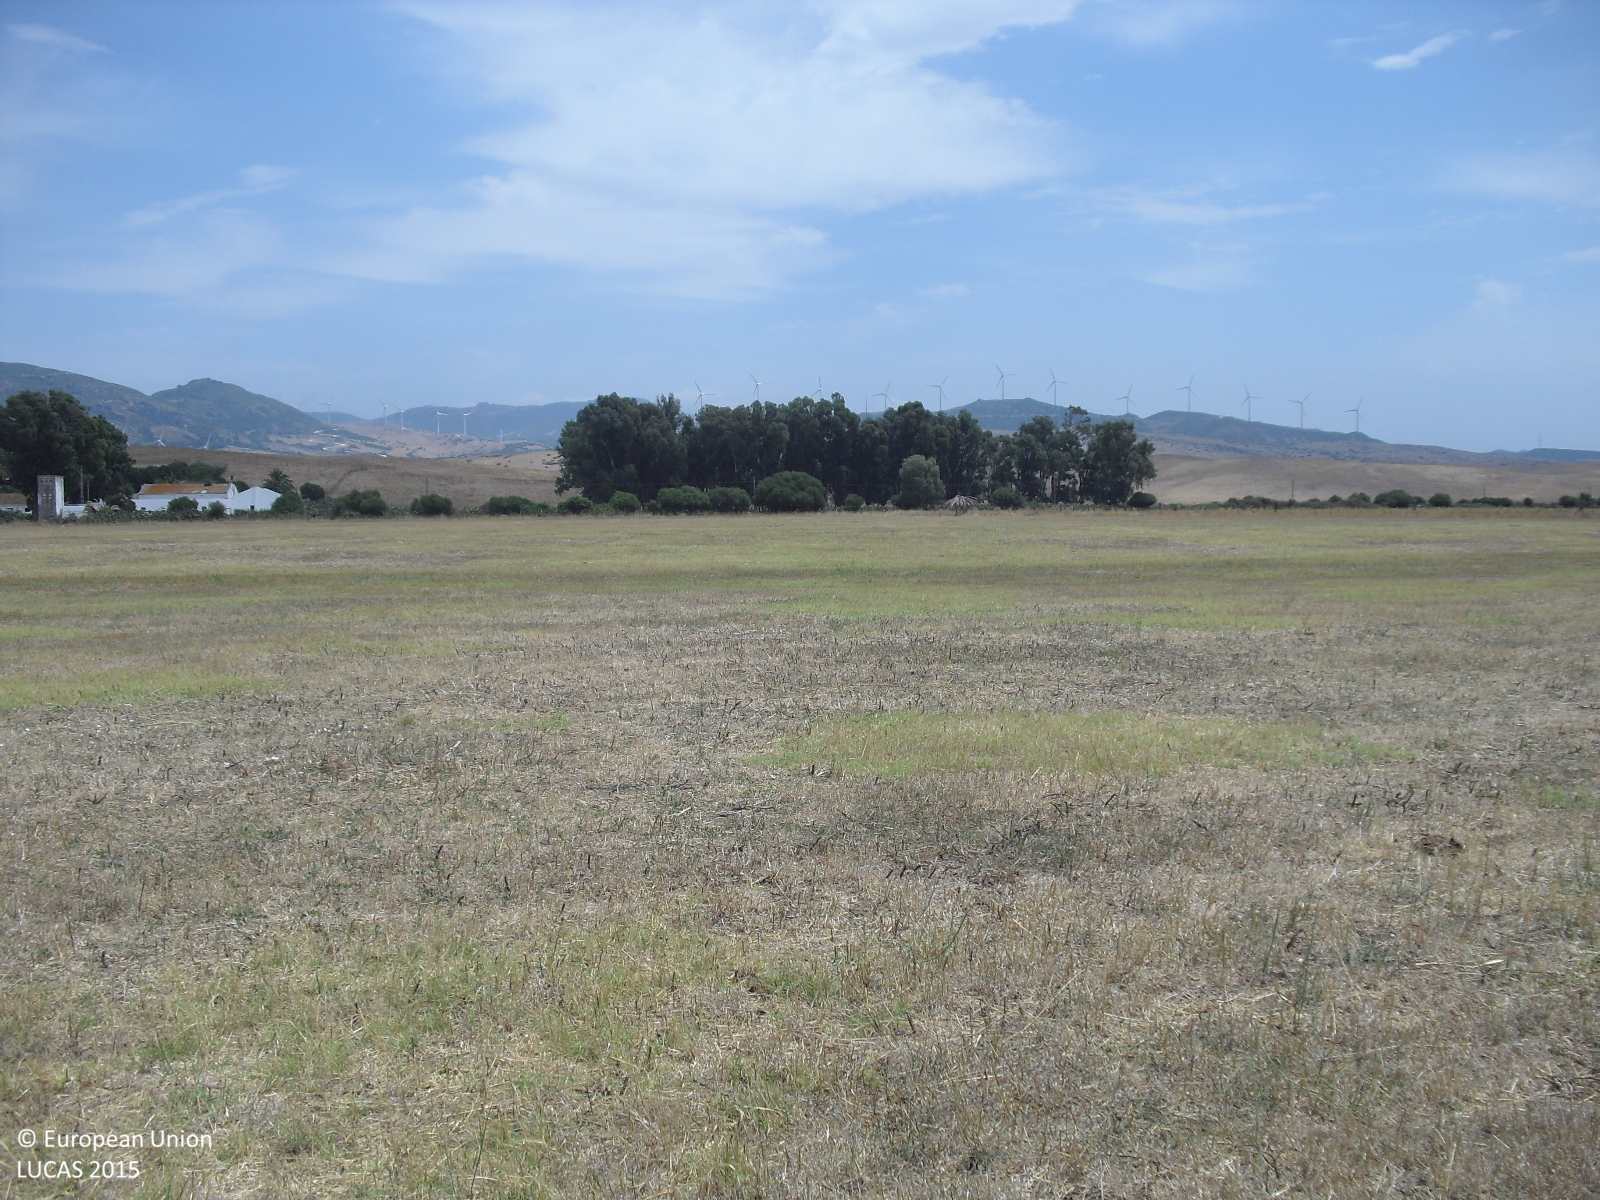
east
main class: Grassland
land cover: Spontaneously vegetated surfaces
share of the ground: 25 - 50 %
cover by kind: unconsolidated bare surface 65 %, herbaceous plants 35 %
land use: Agriculture (excluding fallow land and kitchen gardens)
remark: Harvested field
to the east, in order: Spontaneously vegetated surfaces; Other structural elements; Spontaneously vegetated surfaces; Grass margins
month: July
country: ES
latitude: 36.0585
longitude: -5.6344
